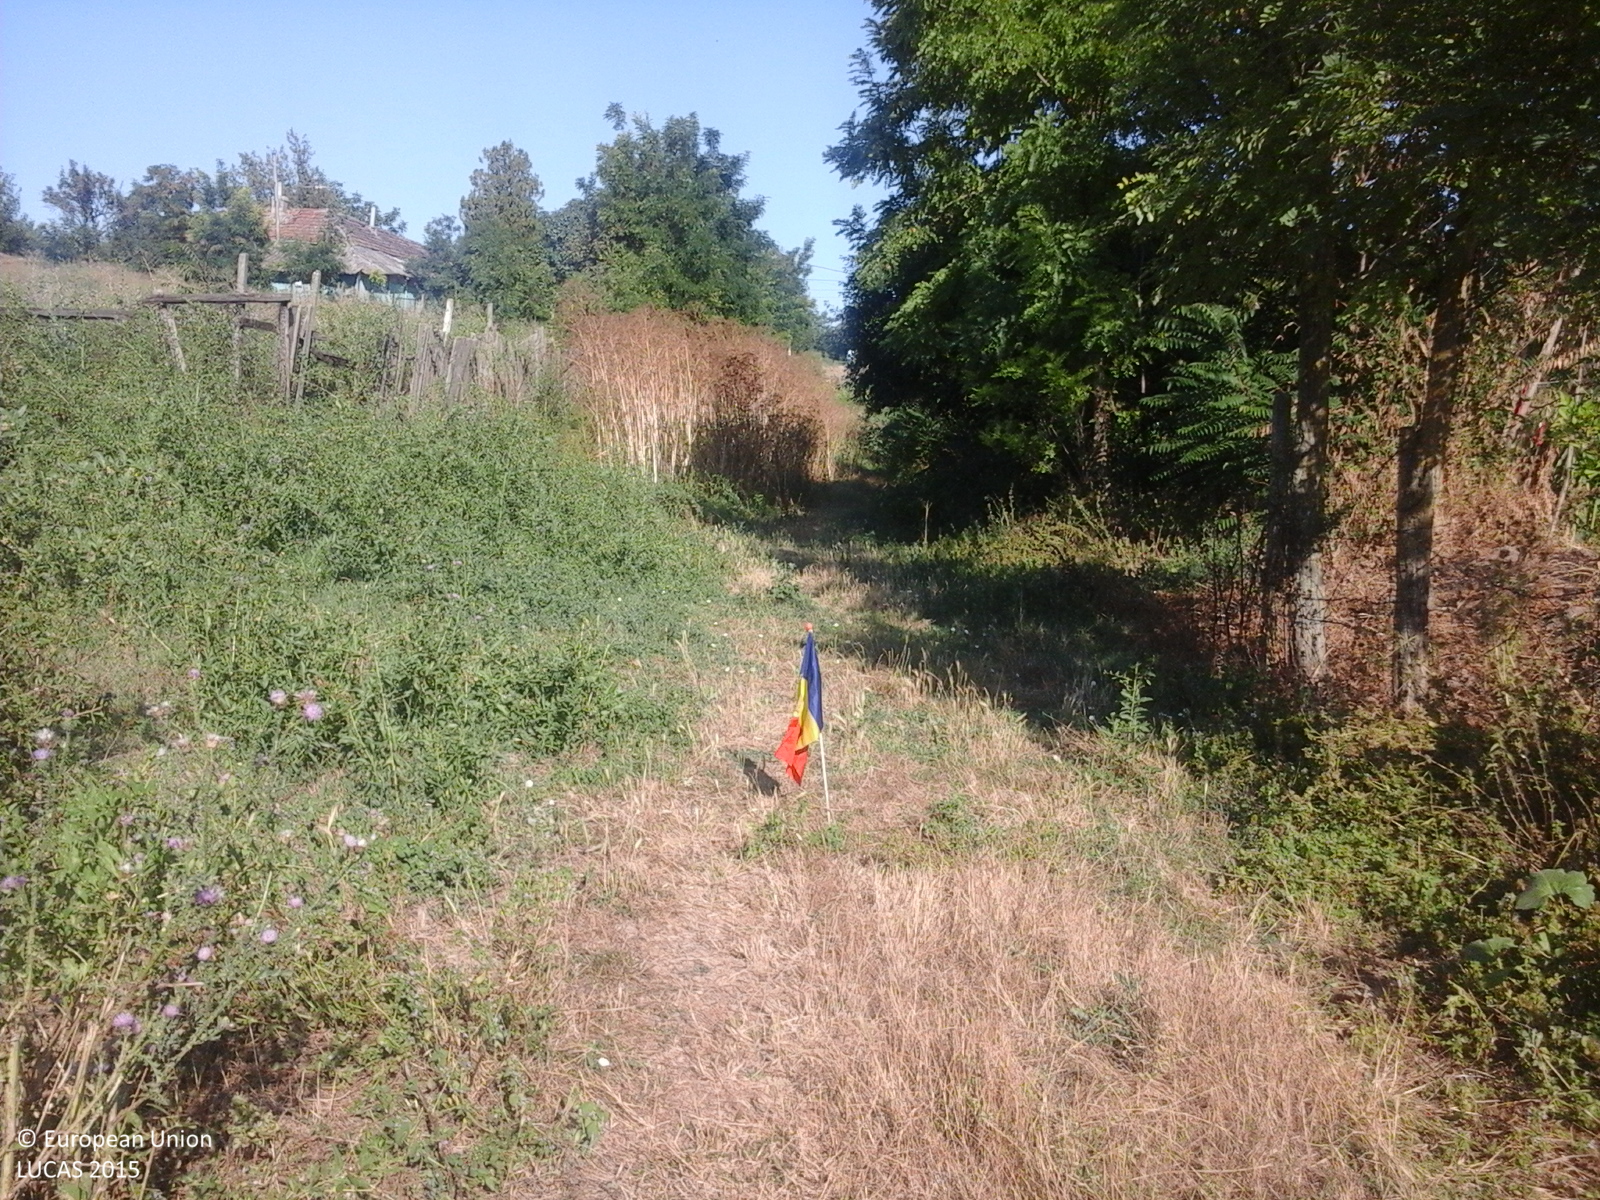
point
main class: Cropland
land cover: Maize
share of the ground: > 75 %
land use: Agriculture (excluding fallow land and kitchen gardens)
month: August
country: RO
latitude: 44.6377
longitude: 28.1280
